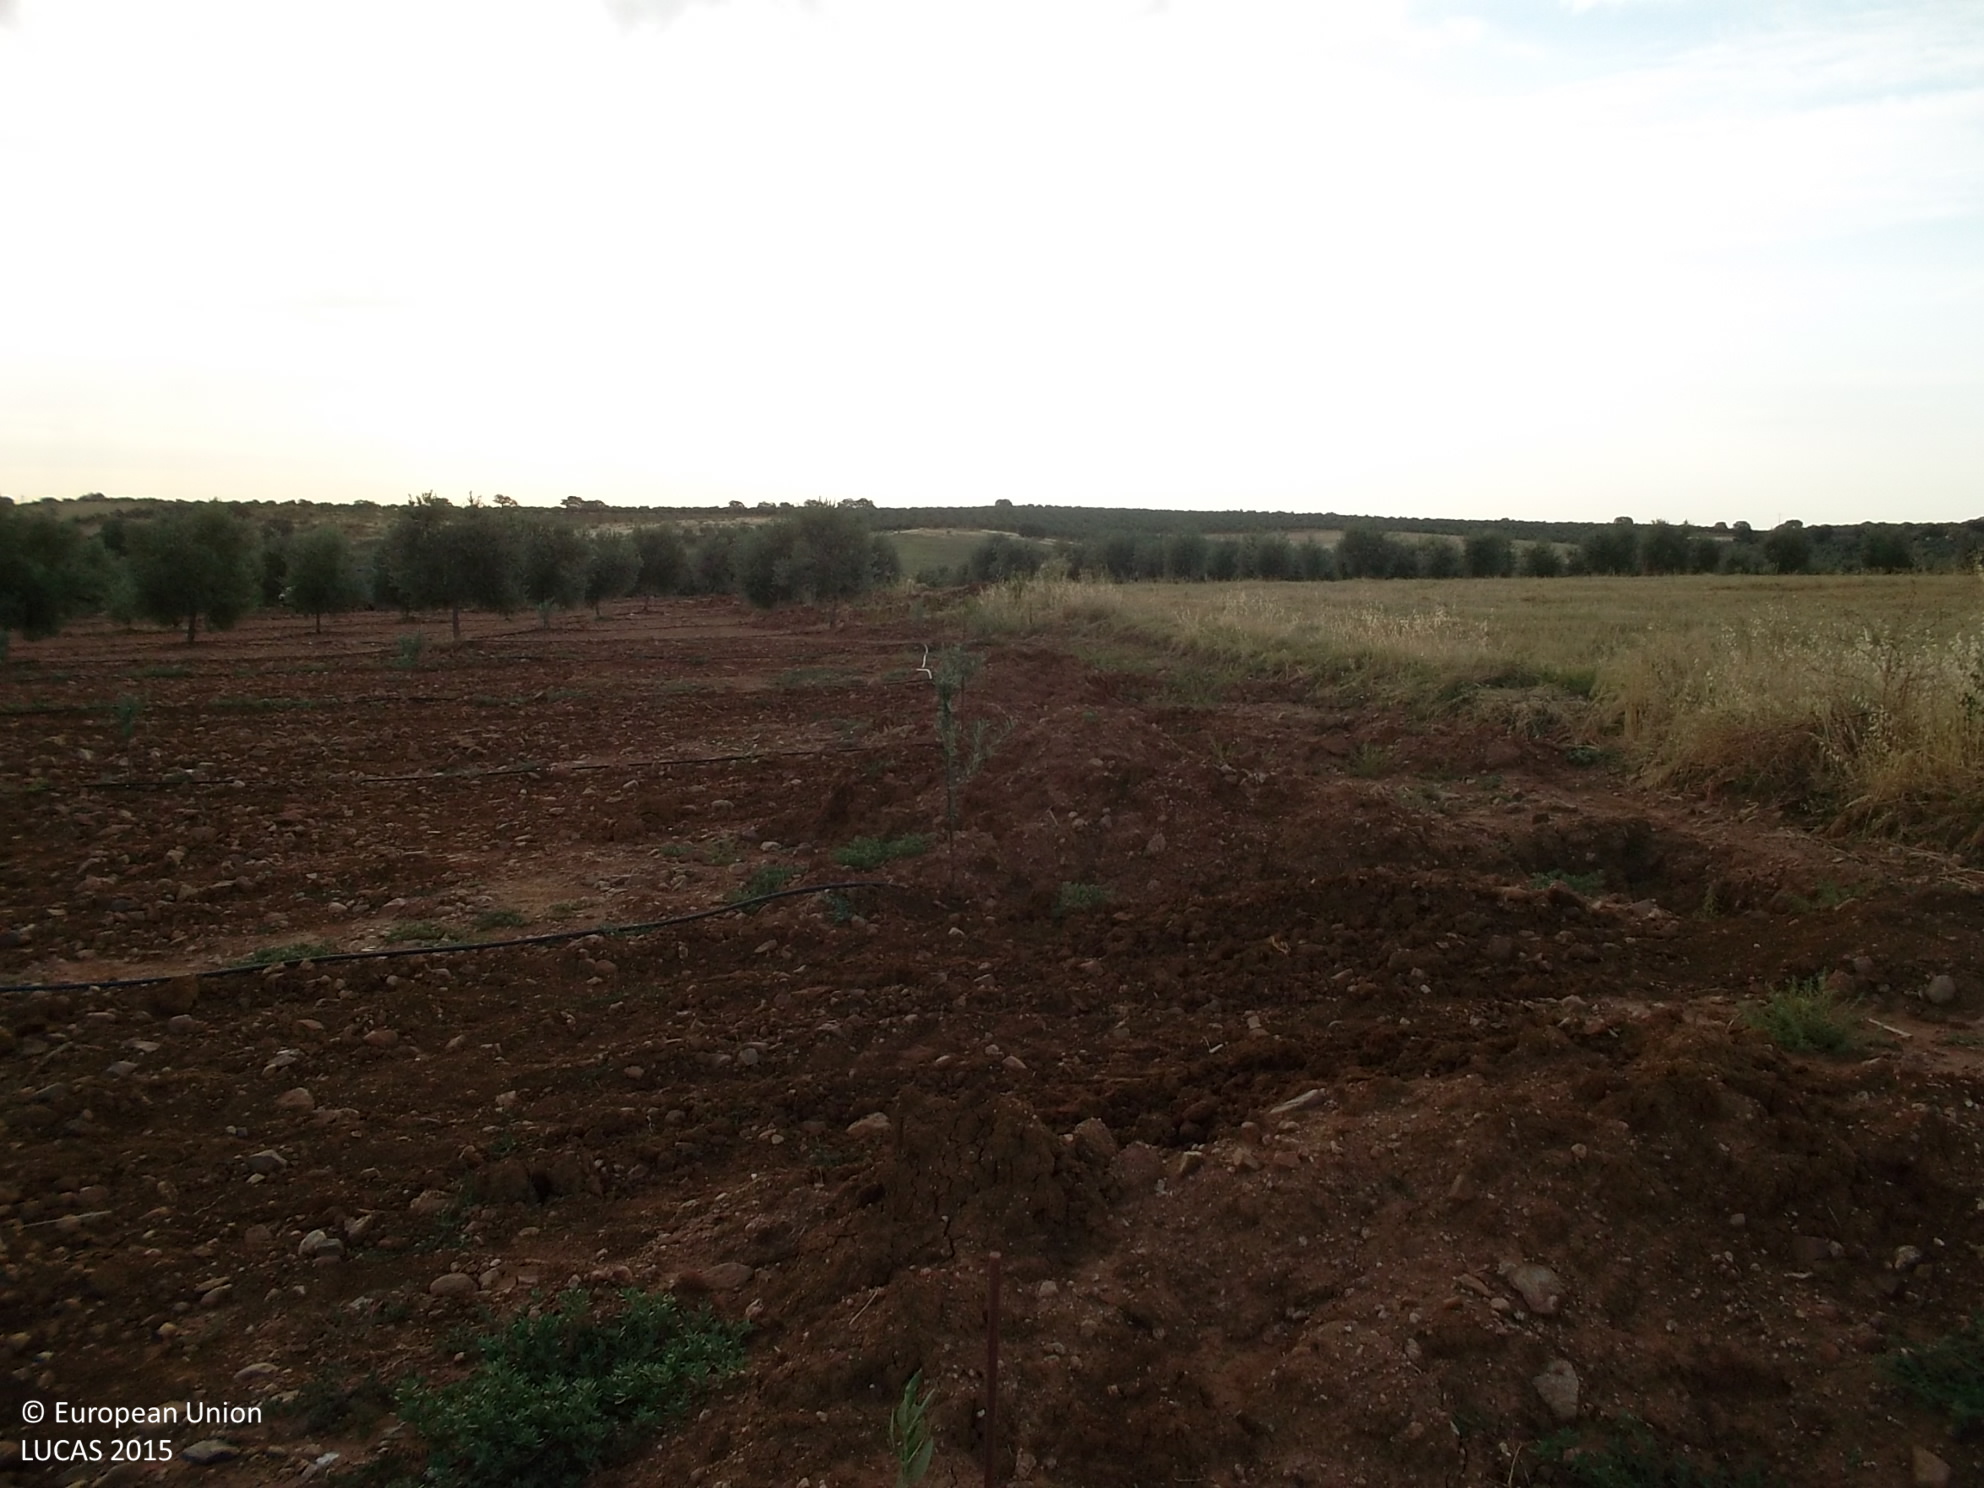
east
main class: Cropland
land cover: Olive groves
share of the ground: 10 - 25 %
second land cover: Other bare soil
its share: > 75 %
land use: Agriculture (excluding fallow land and kitchen gardens)
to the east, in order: Olive groves; Other bare soil; Grass margins; Olive groves; Tracks; Olive groves; Spontaneously vegetated surfaces
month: July
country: ES
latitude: 38.6002
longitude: -5.4105
